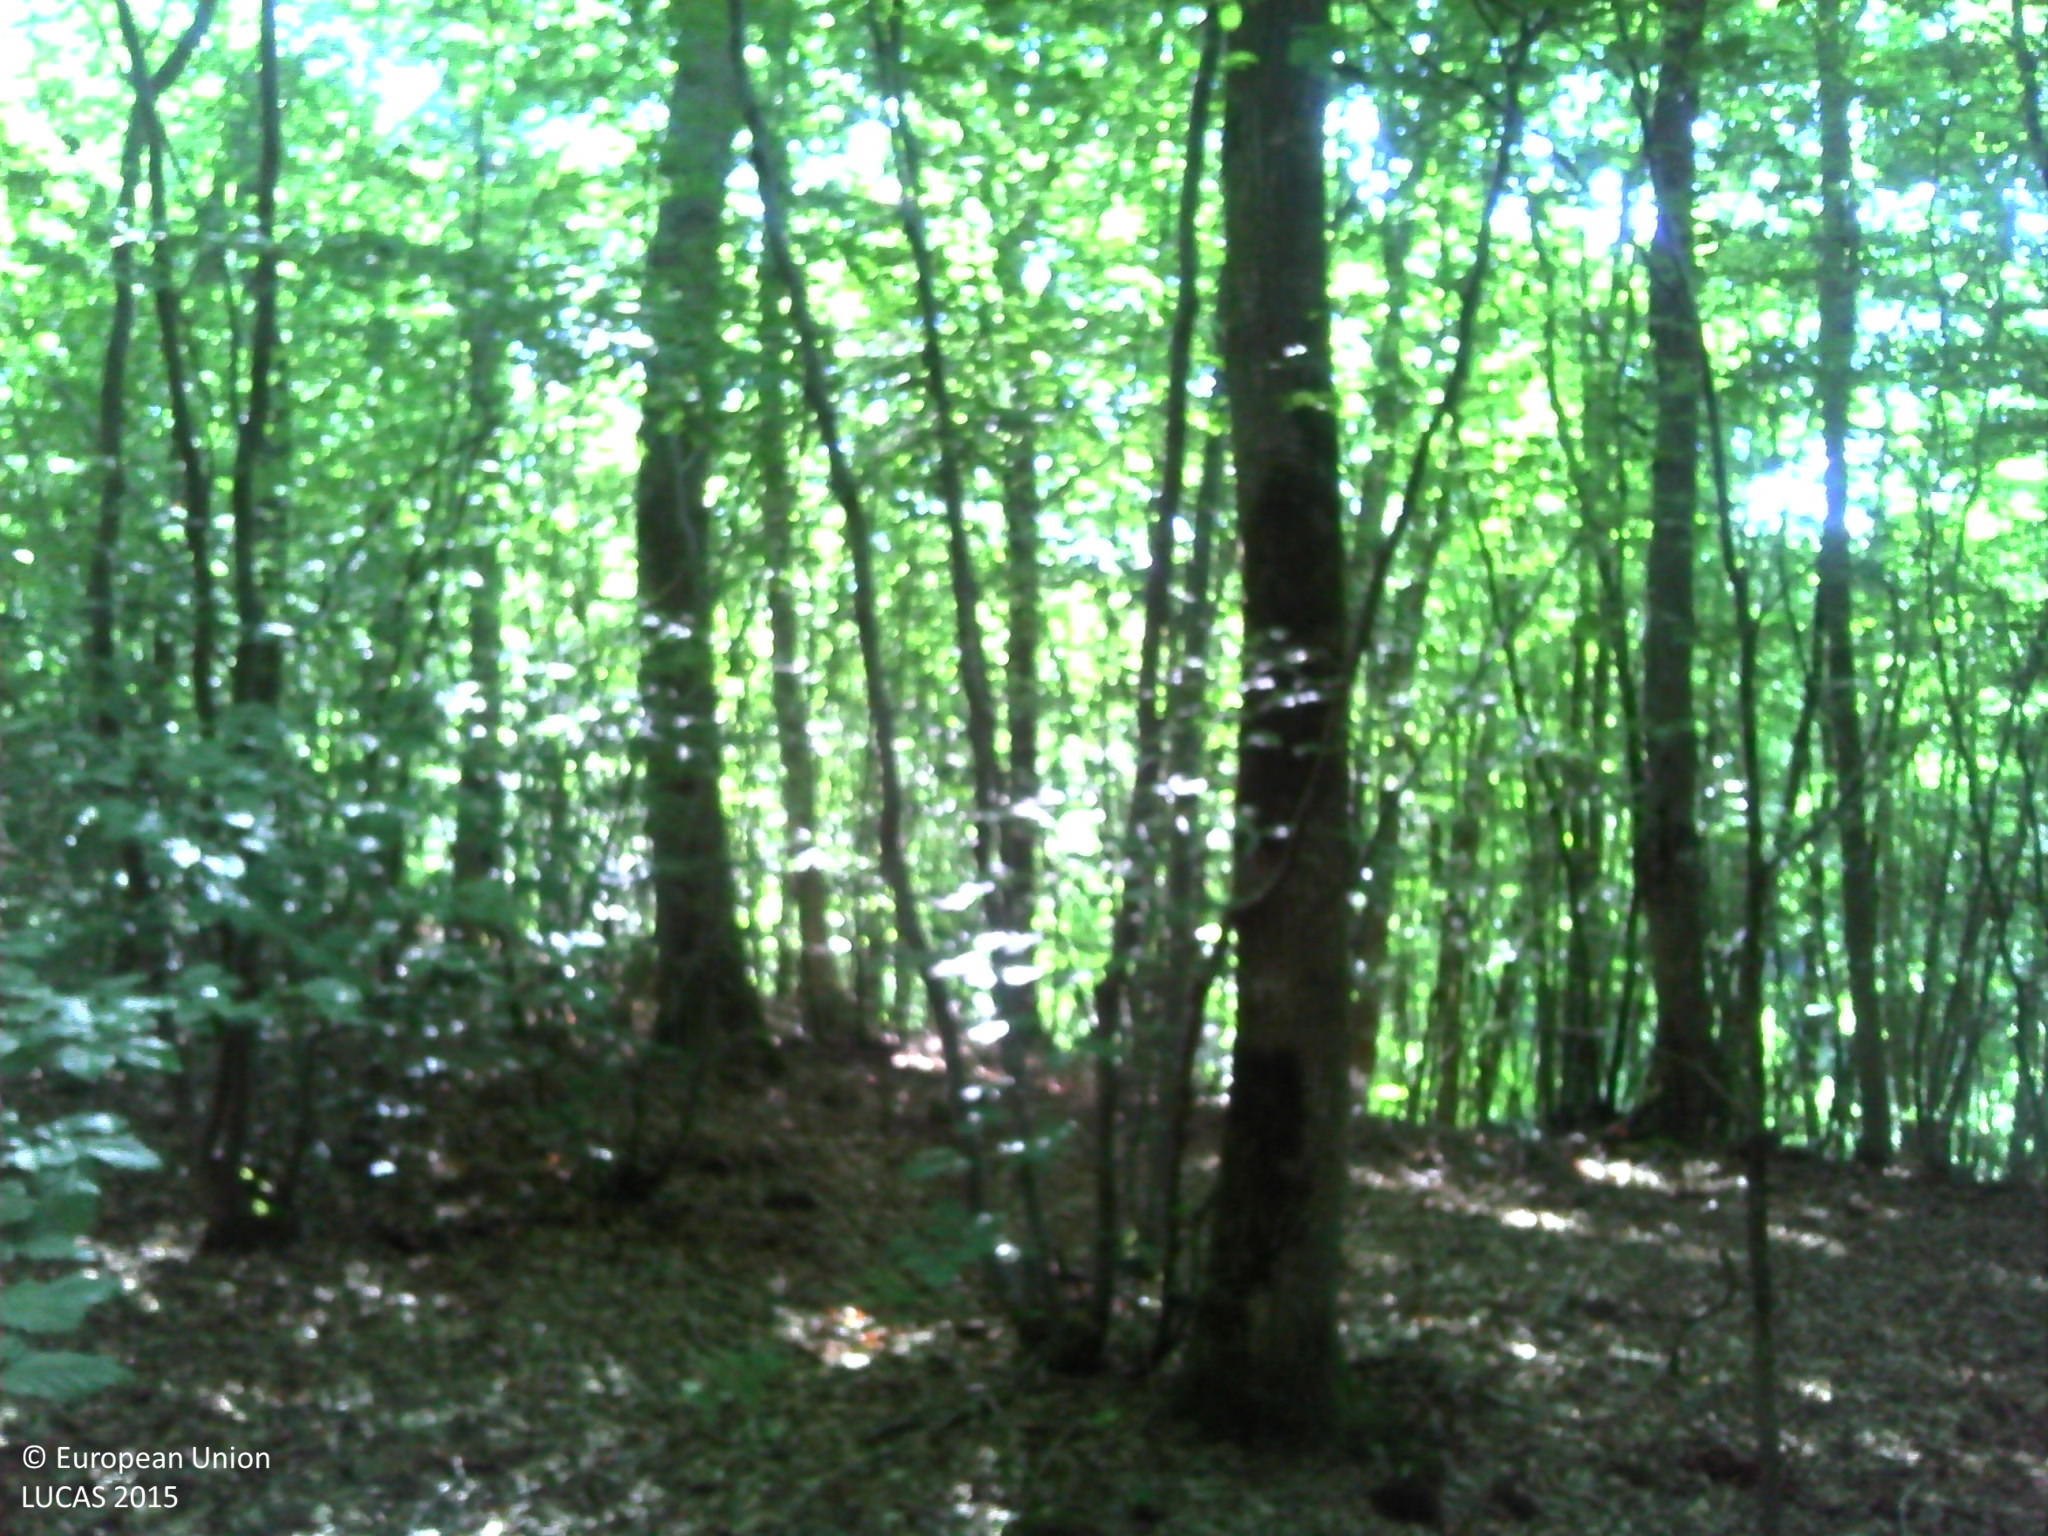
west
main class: Woodland
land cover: Broadleaved woodland
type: acidophilous oak and oak-birch forest
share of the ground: > 75 %
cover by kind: broadleaved forest trees 70 %, herbaceous plants 15 %, consolidated bare surface 15 %
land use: Forestry
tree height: > 5 m
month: July
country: FR
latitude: 49.0620
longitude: 0.7105
